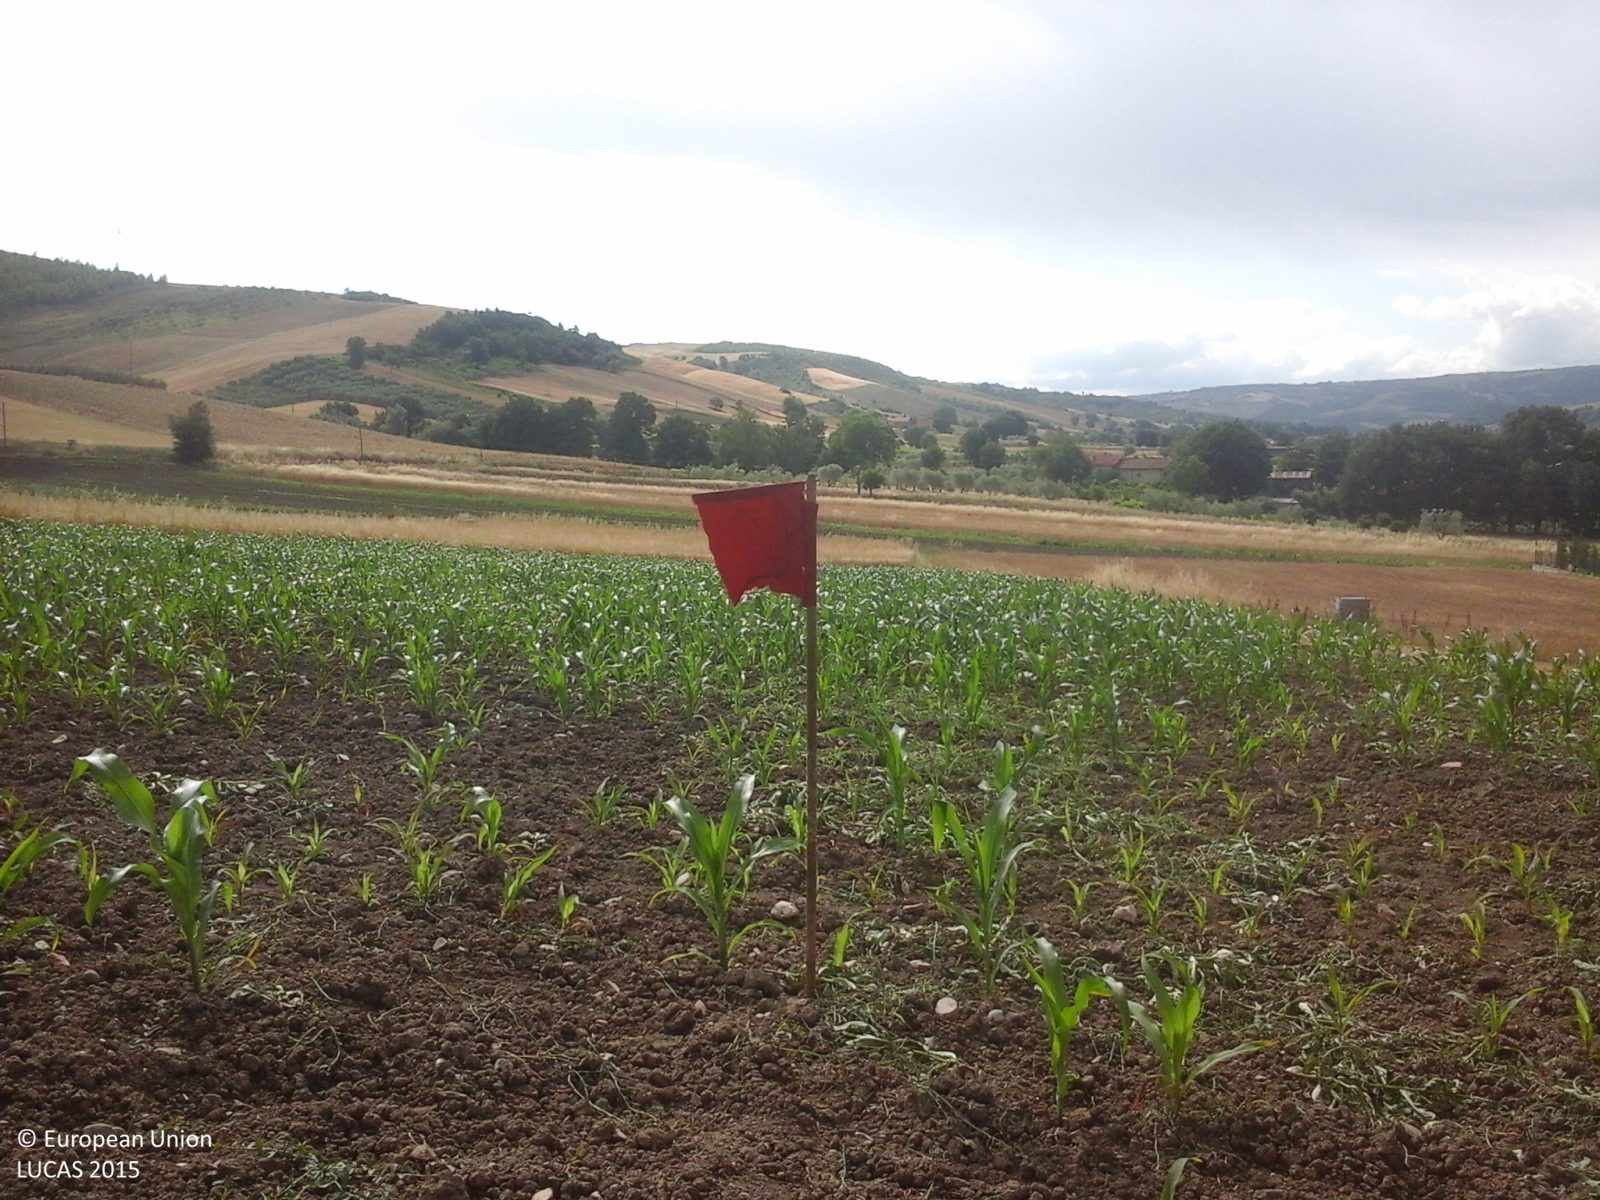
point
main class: Cropland
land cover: Maize
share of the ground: 25 - 50 %
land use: Agriculture (excluding fallow land and kitchen gardens)
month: June
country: IT
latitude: 41.0381
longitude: 15.1552
